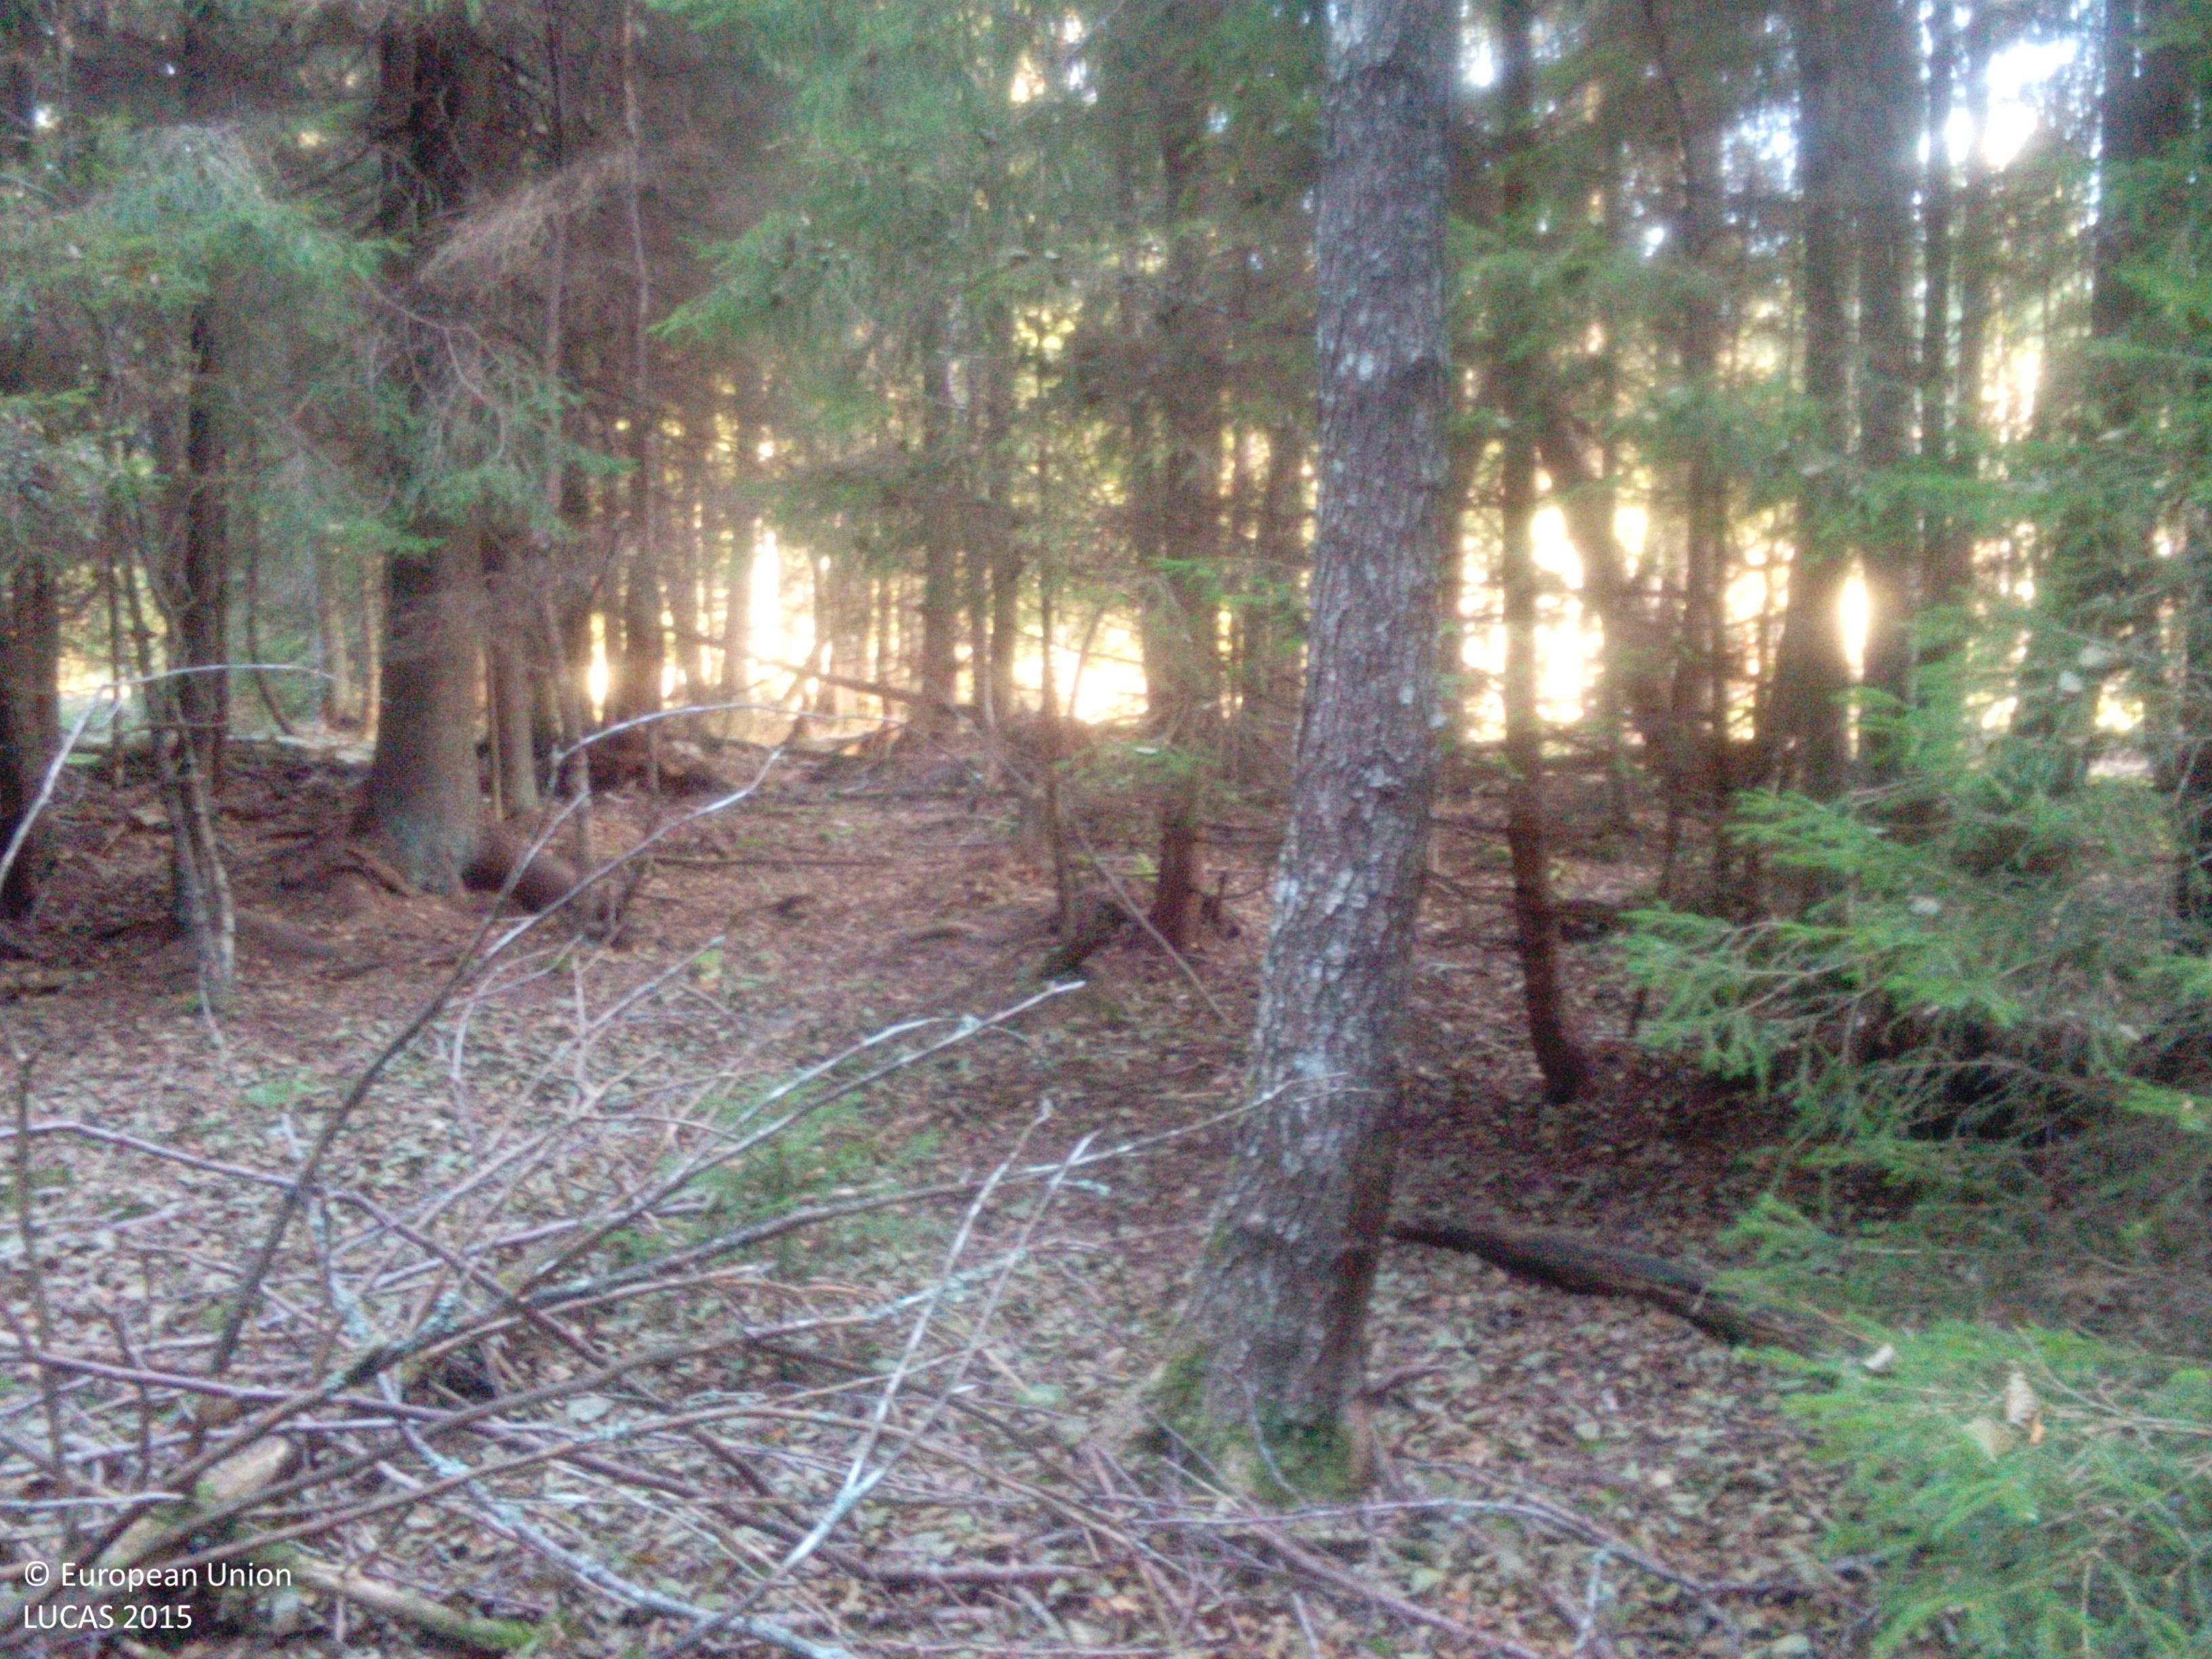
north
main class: Woodland
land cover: Spruce dominated mixed woodland
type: boreal forest
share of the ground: > 75 %
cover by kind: coniferous forest trees 65 %, broadleaved forest trees 30 %, lichens and mosses 5 %
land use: Forestry
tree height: > 5 m
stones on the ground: < 10 %
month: October
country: SE
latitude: 58.9219
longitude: 16.2640
